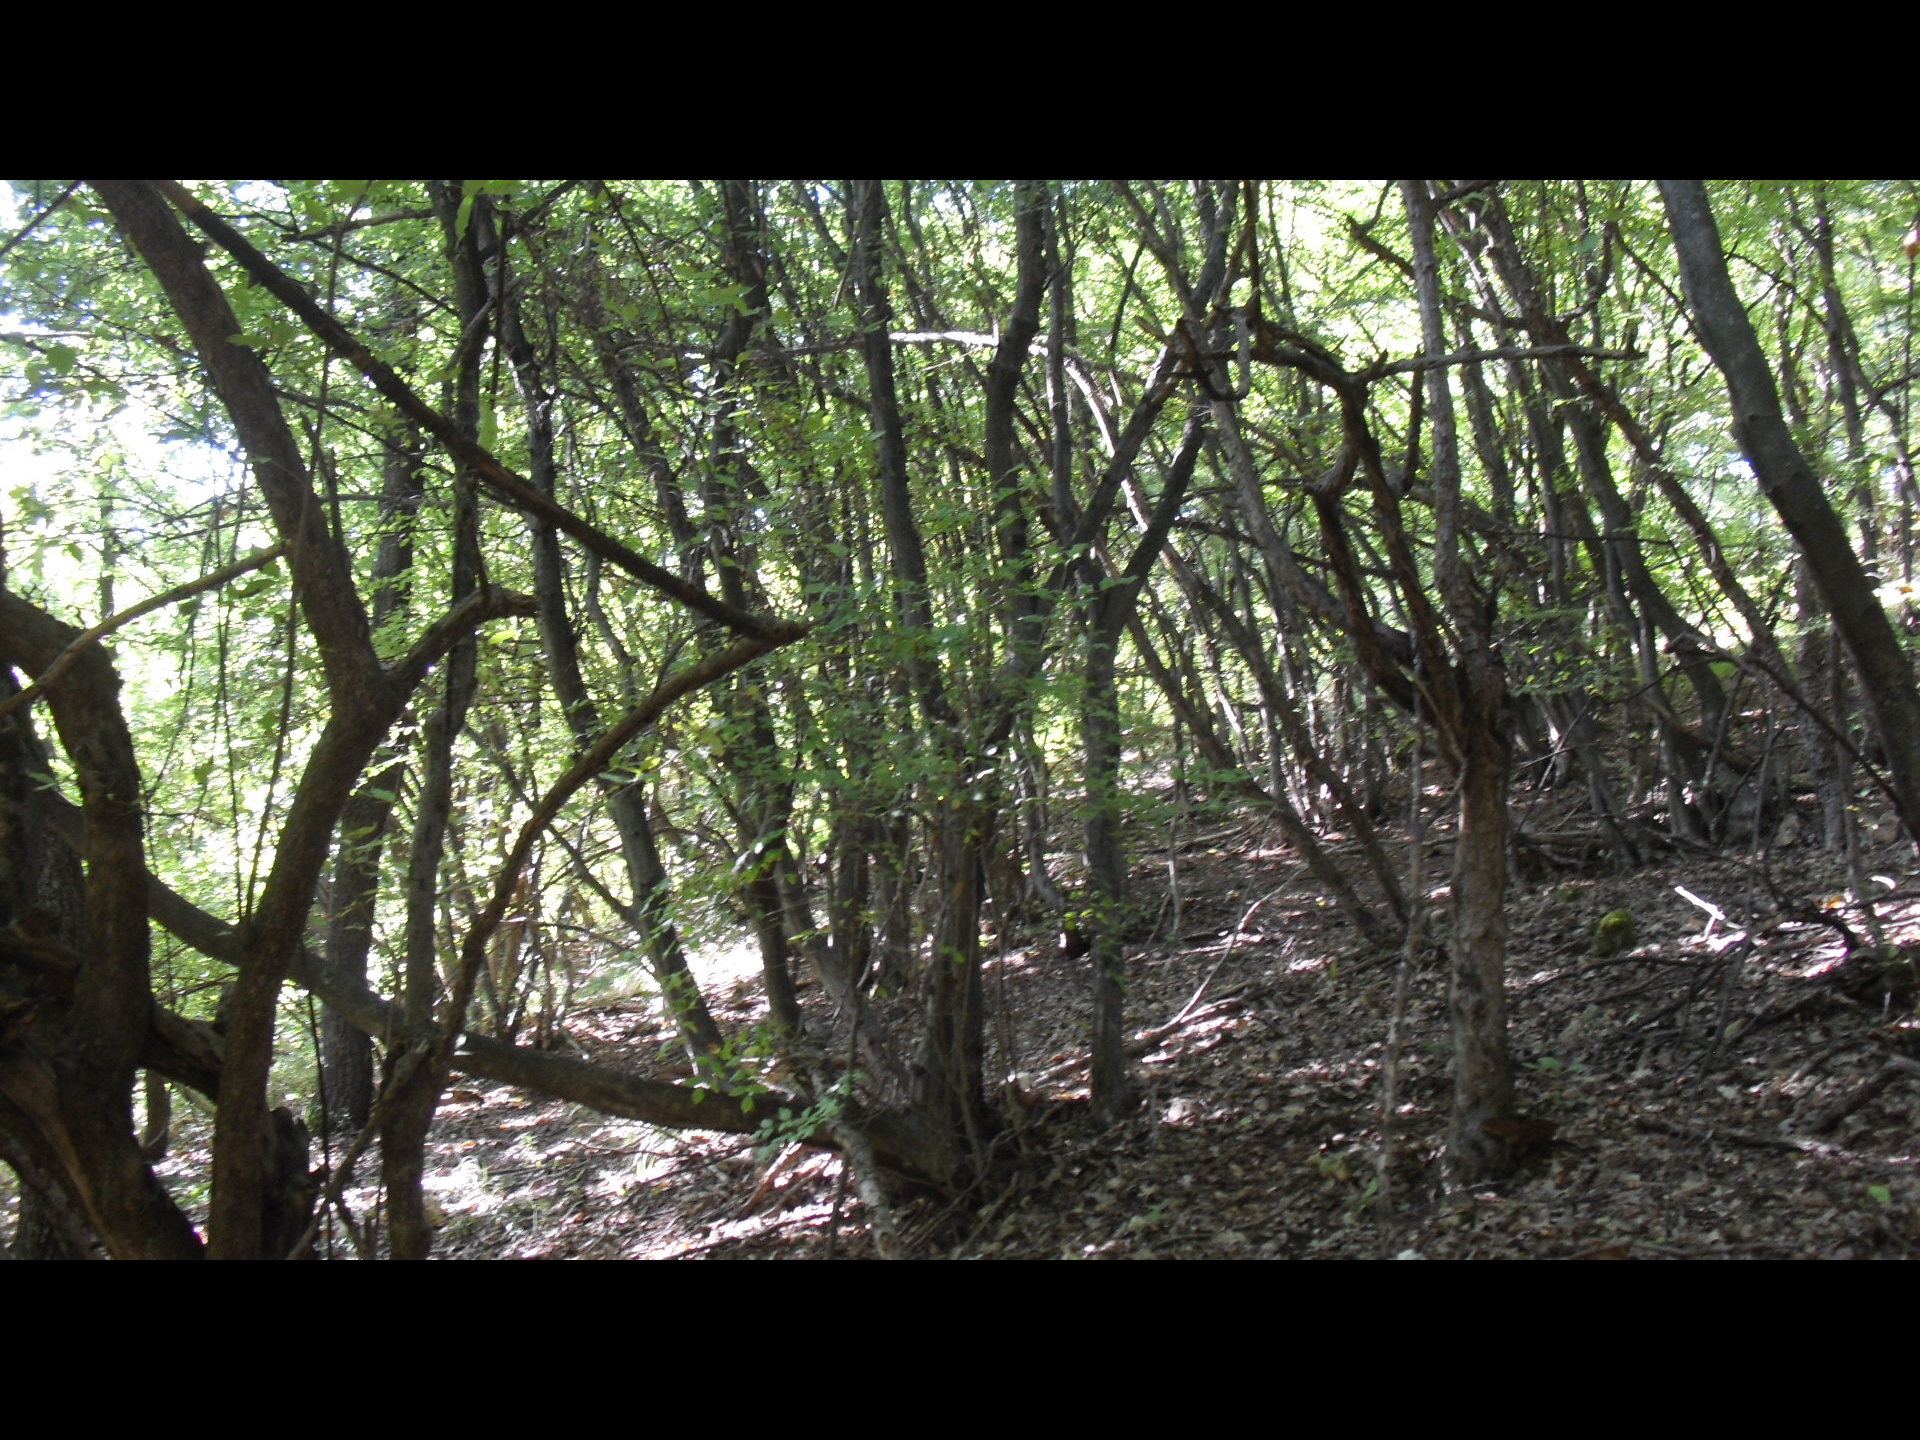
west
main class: Woodland
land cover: Broadleaved woodland
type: mesophytic deciduous forest
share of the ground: > 75 %
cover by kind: broadleaved forest trees 80 %, unconsolidated bare surface 20 %
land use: Forestry
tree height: > 5 m
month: October
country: BG
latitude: 43.8954
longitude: 22.6969
